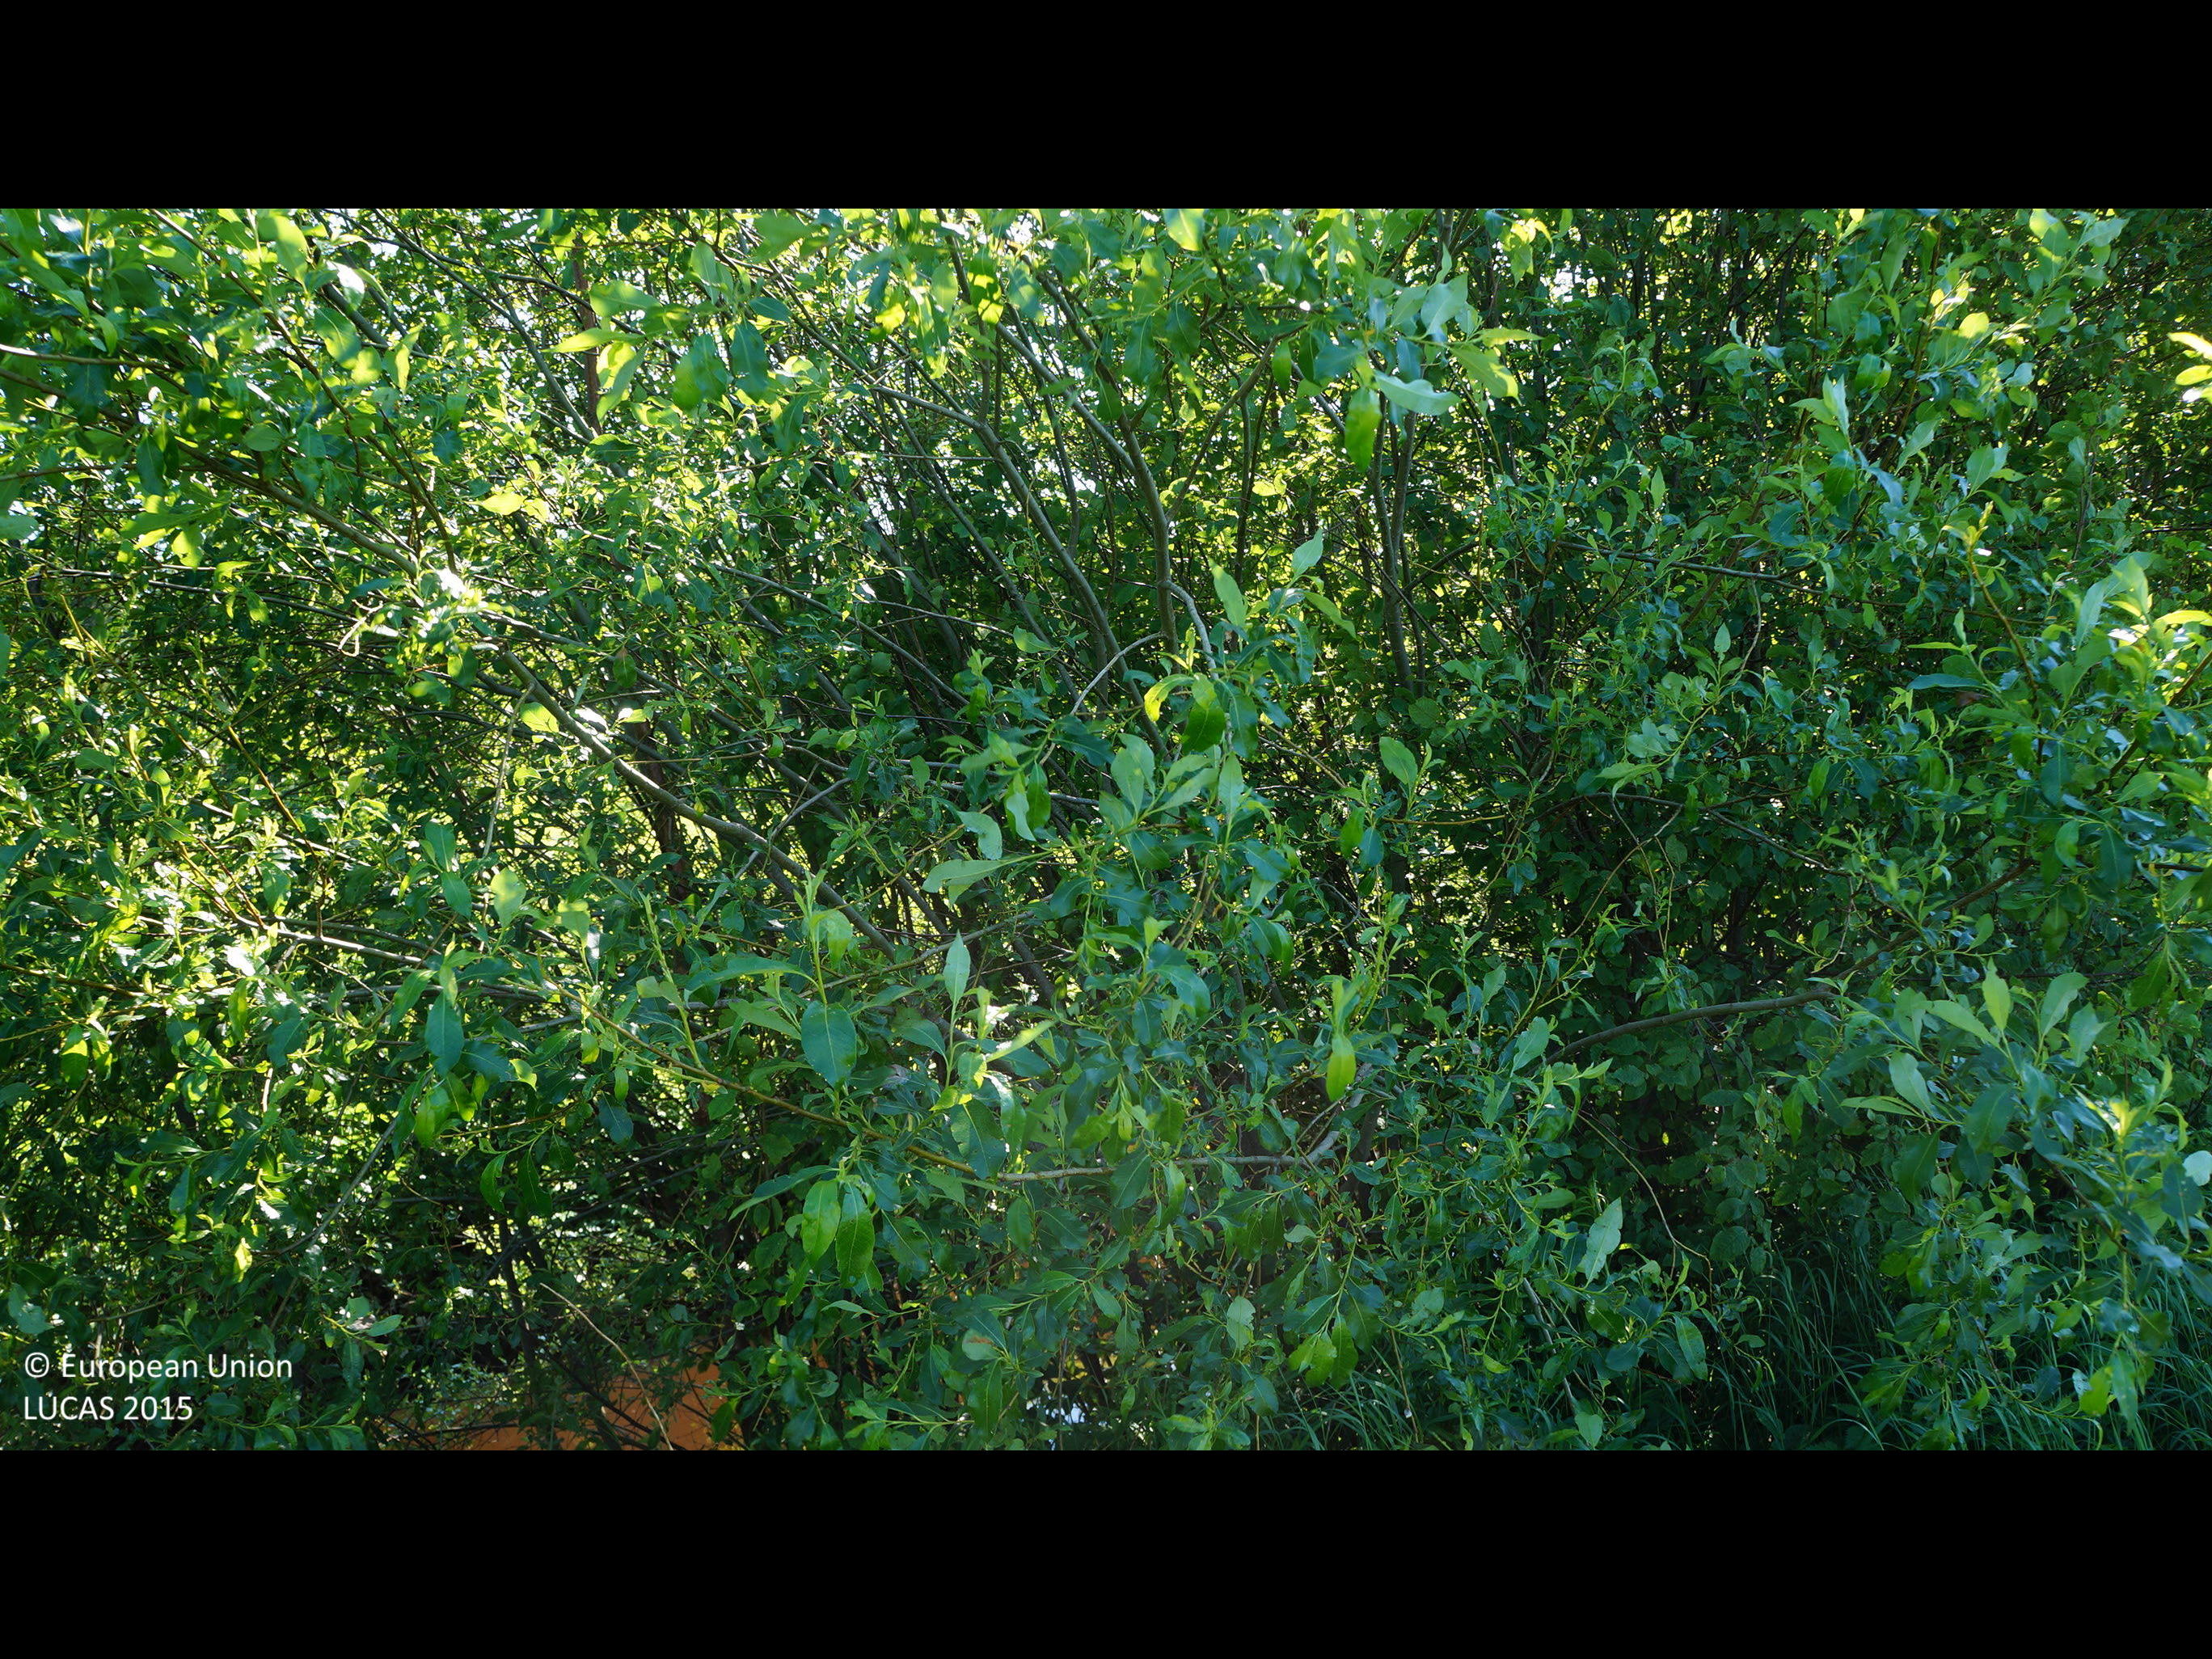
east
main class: Cropland
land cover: Barley
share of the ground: 25 - 50 %
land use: Agriculture (excluding fallow land and kitchen gardens)
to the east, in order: Barley; Abandoned hedges; Rivers and streams; Temporary grasslands; Ditches and canals; Abandoned hedges; Shruby margins; Spruce dominated coniferous woodland; Tracks; Spruce dominated coniferous woodland; Tracks; Spruce dominated coniferous woodland
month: June
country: FI
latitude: 64.1227
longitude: 23.7992
